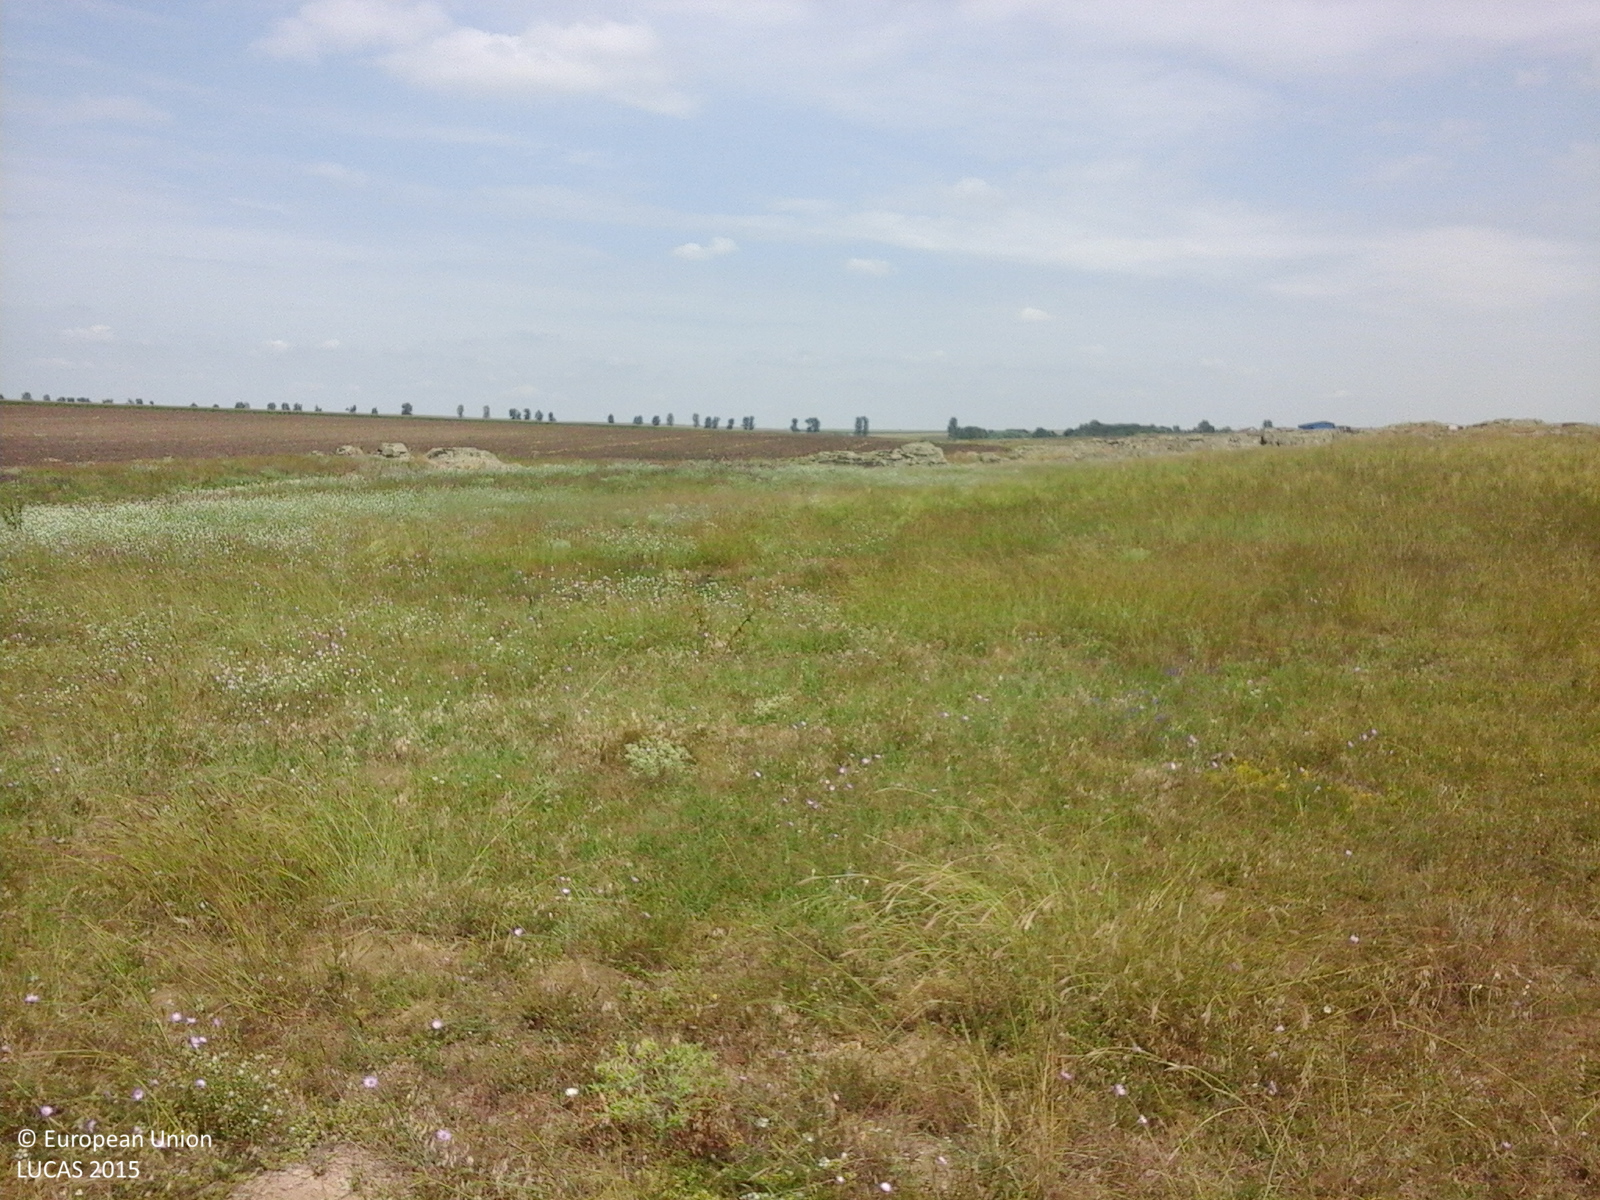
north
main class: Grassland
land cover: Spontaneously vegetated surfaces
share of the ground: > 75 %
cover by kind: herbaceous plants 100 %
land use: Fallow land
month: August
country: RO
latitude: 44.6852
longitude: 28.4826
